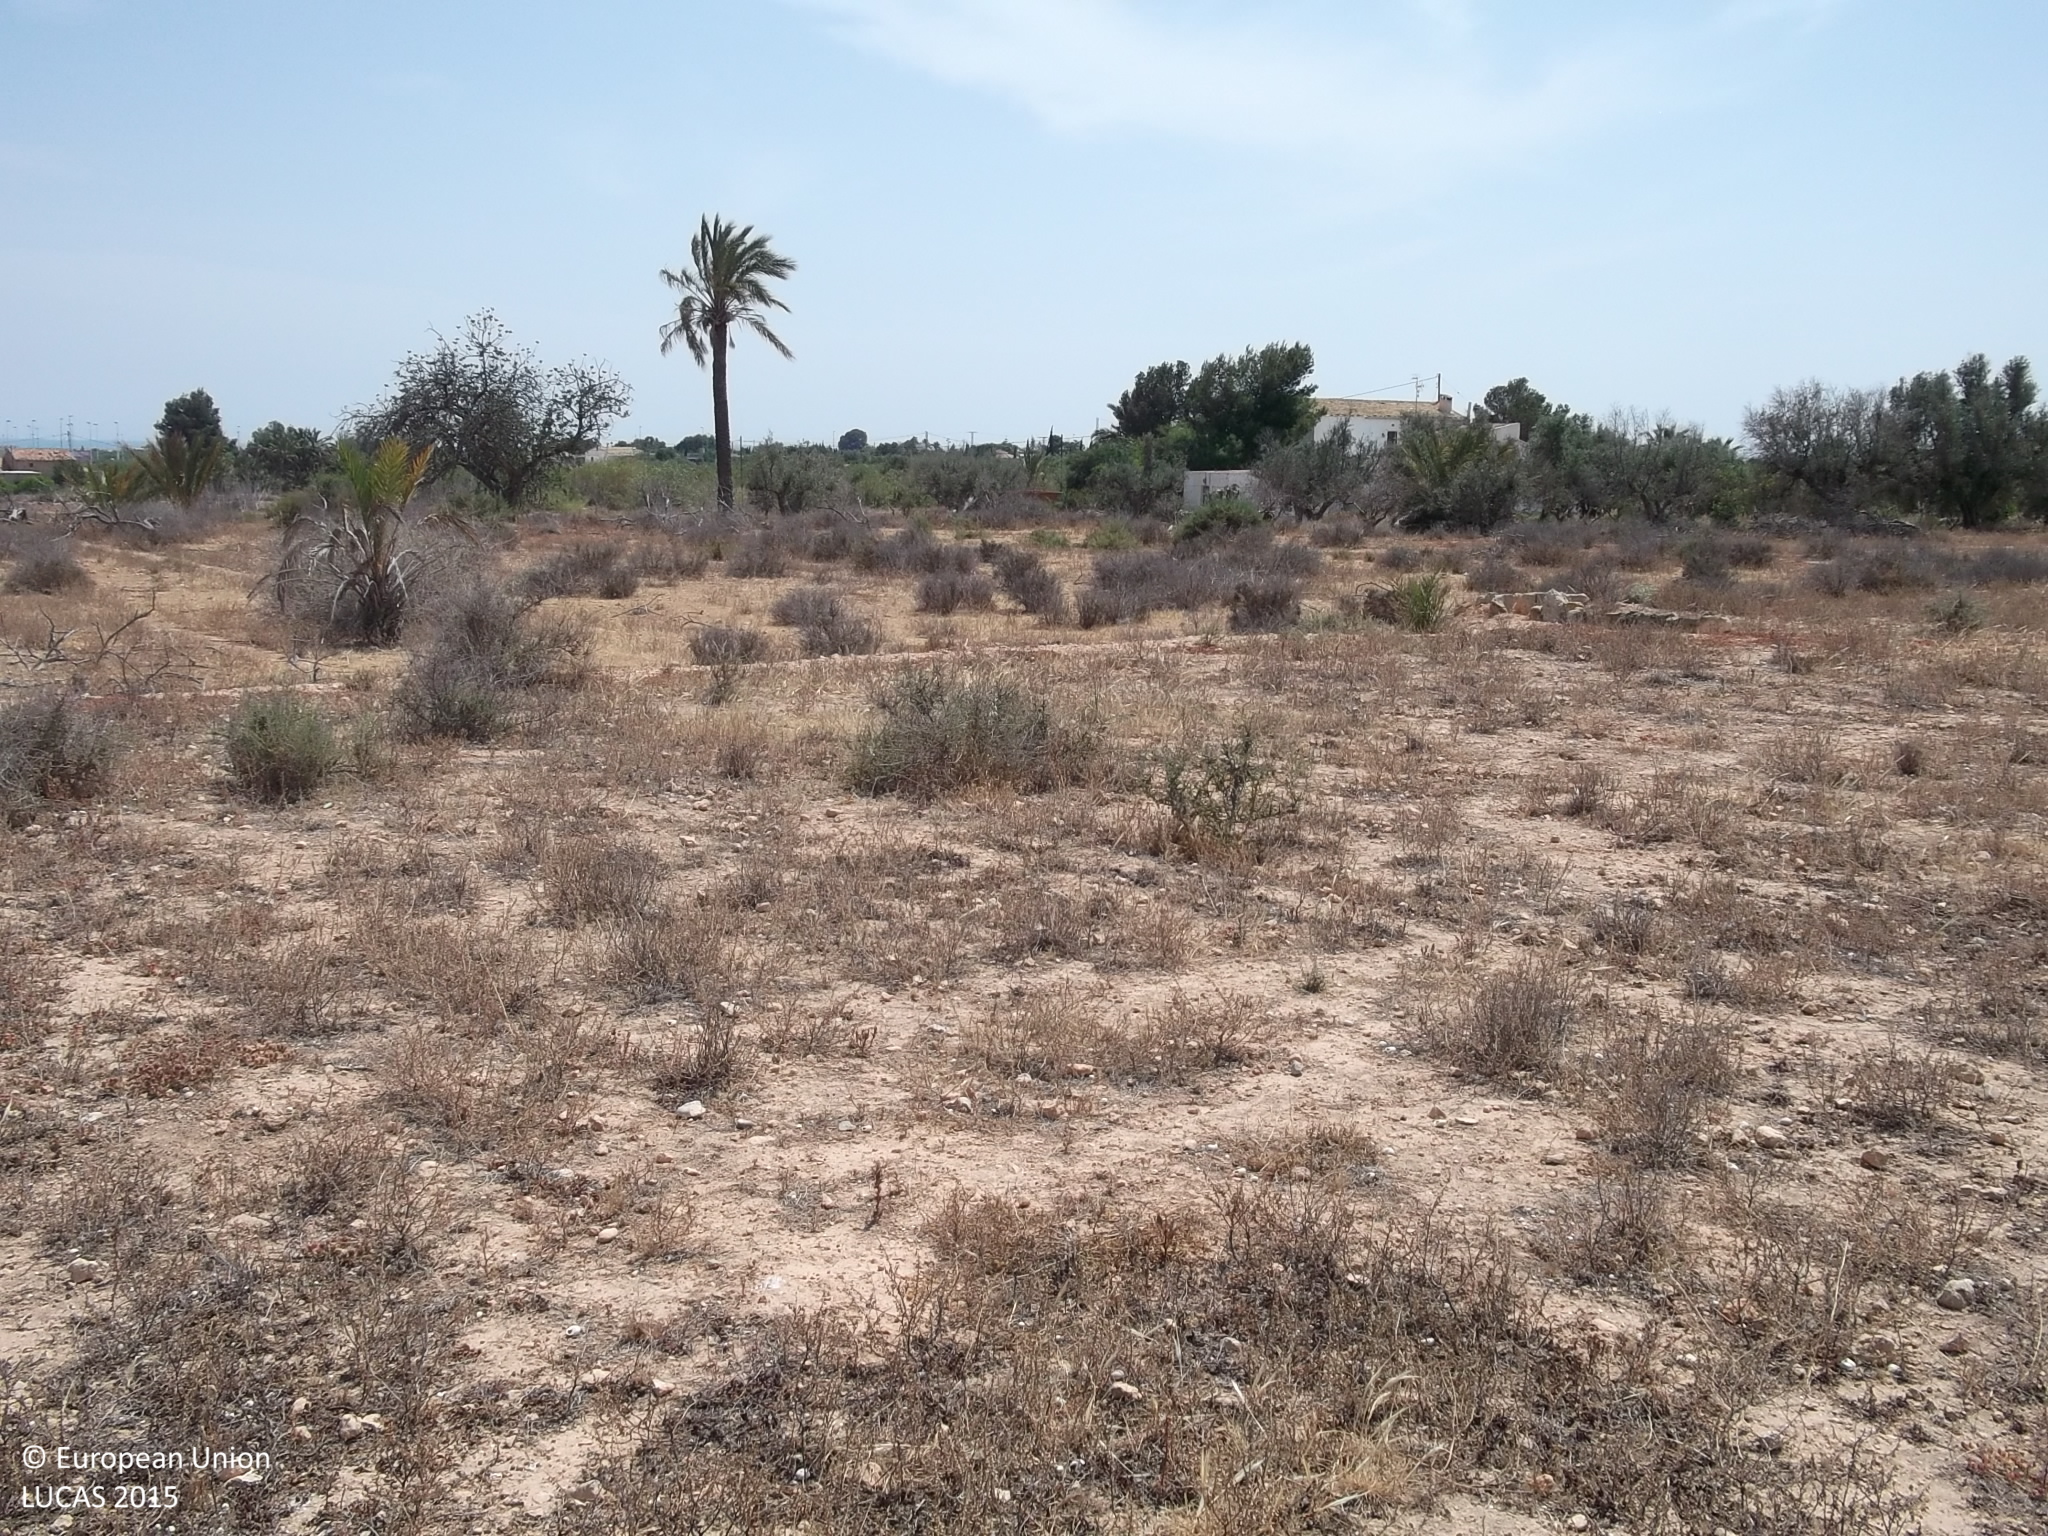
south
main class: Grassland
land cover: Grassland without tree/shrub cover
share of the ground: 50 - 75 %
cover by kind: herbaceous plants 60 %, unconsolidated bare surface 40 %
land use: Abandoned areas
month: May
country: ES
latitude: 38.3010
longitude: -0.6314
